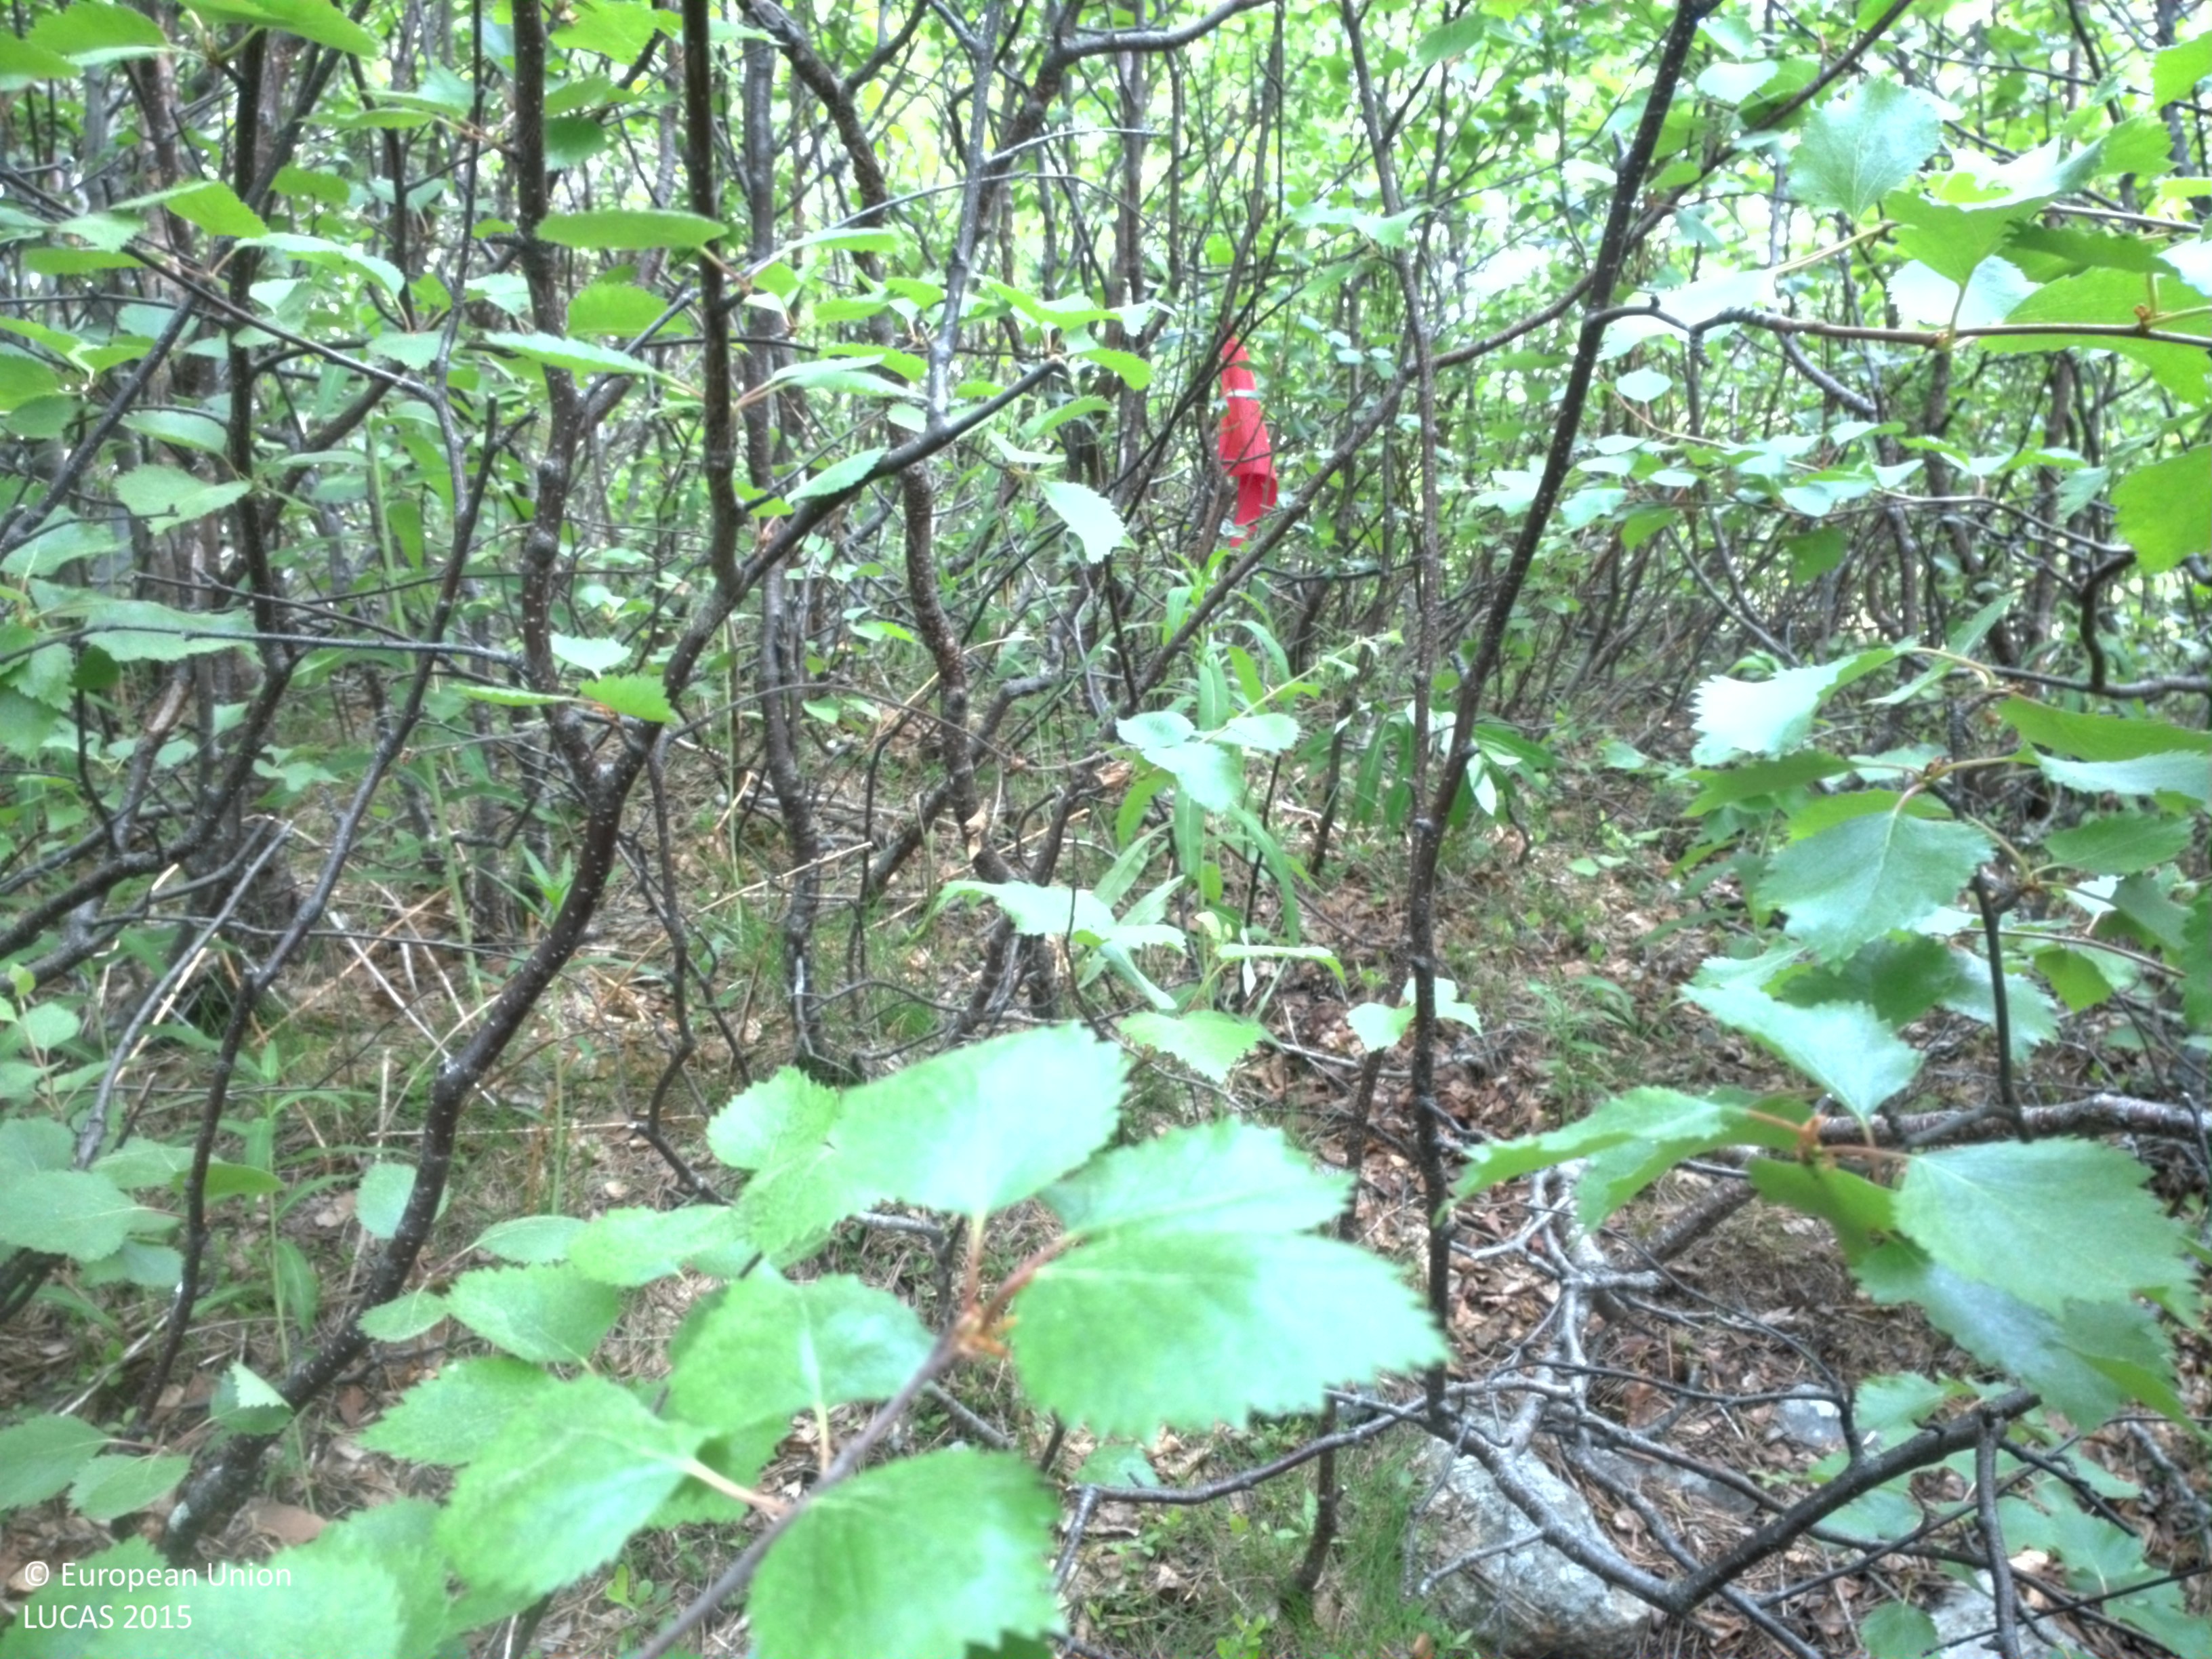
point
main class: Woodland
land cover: Broadleaved woodland
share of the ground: > 75 %
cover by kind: broadleaved forest trees 90 %, coniferous forest trees 5 %, shrubs 5 %
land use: Forestry
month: July
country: SE
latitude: 67.5050
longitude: 18.4433
